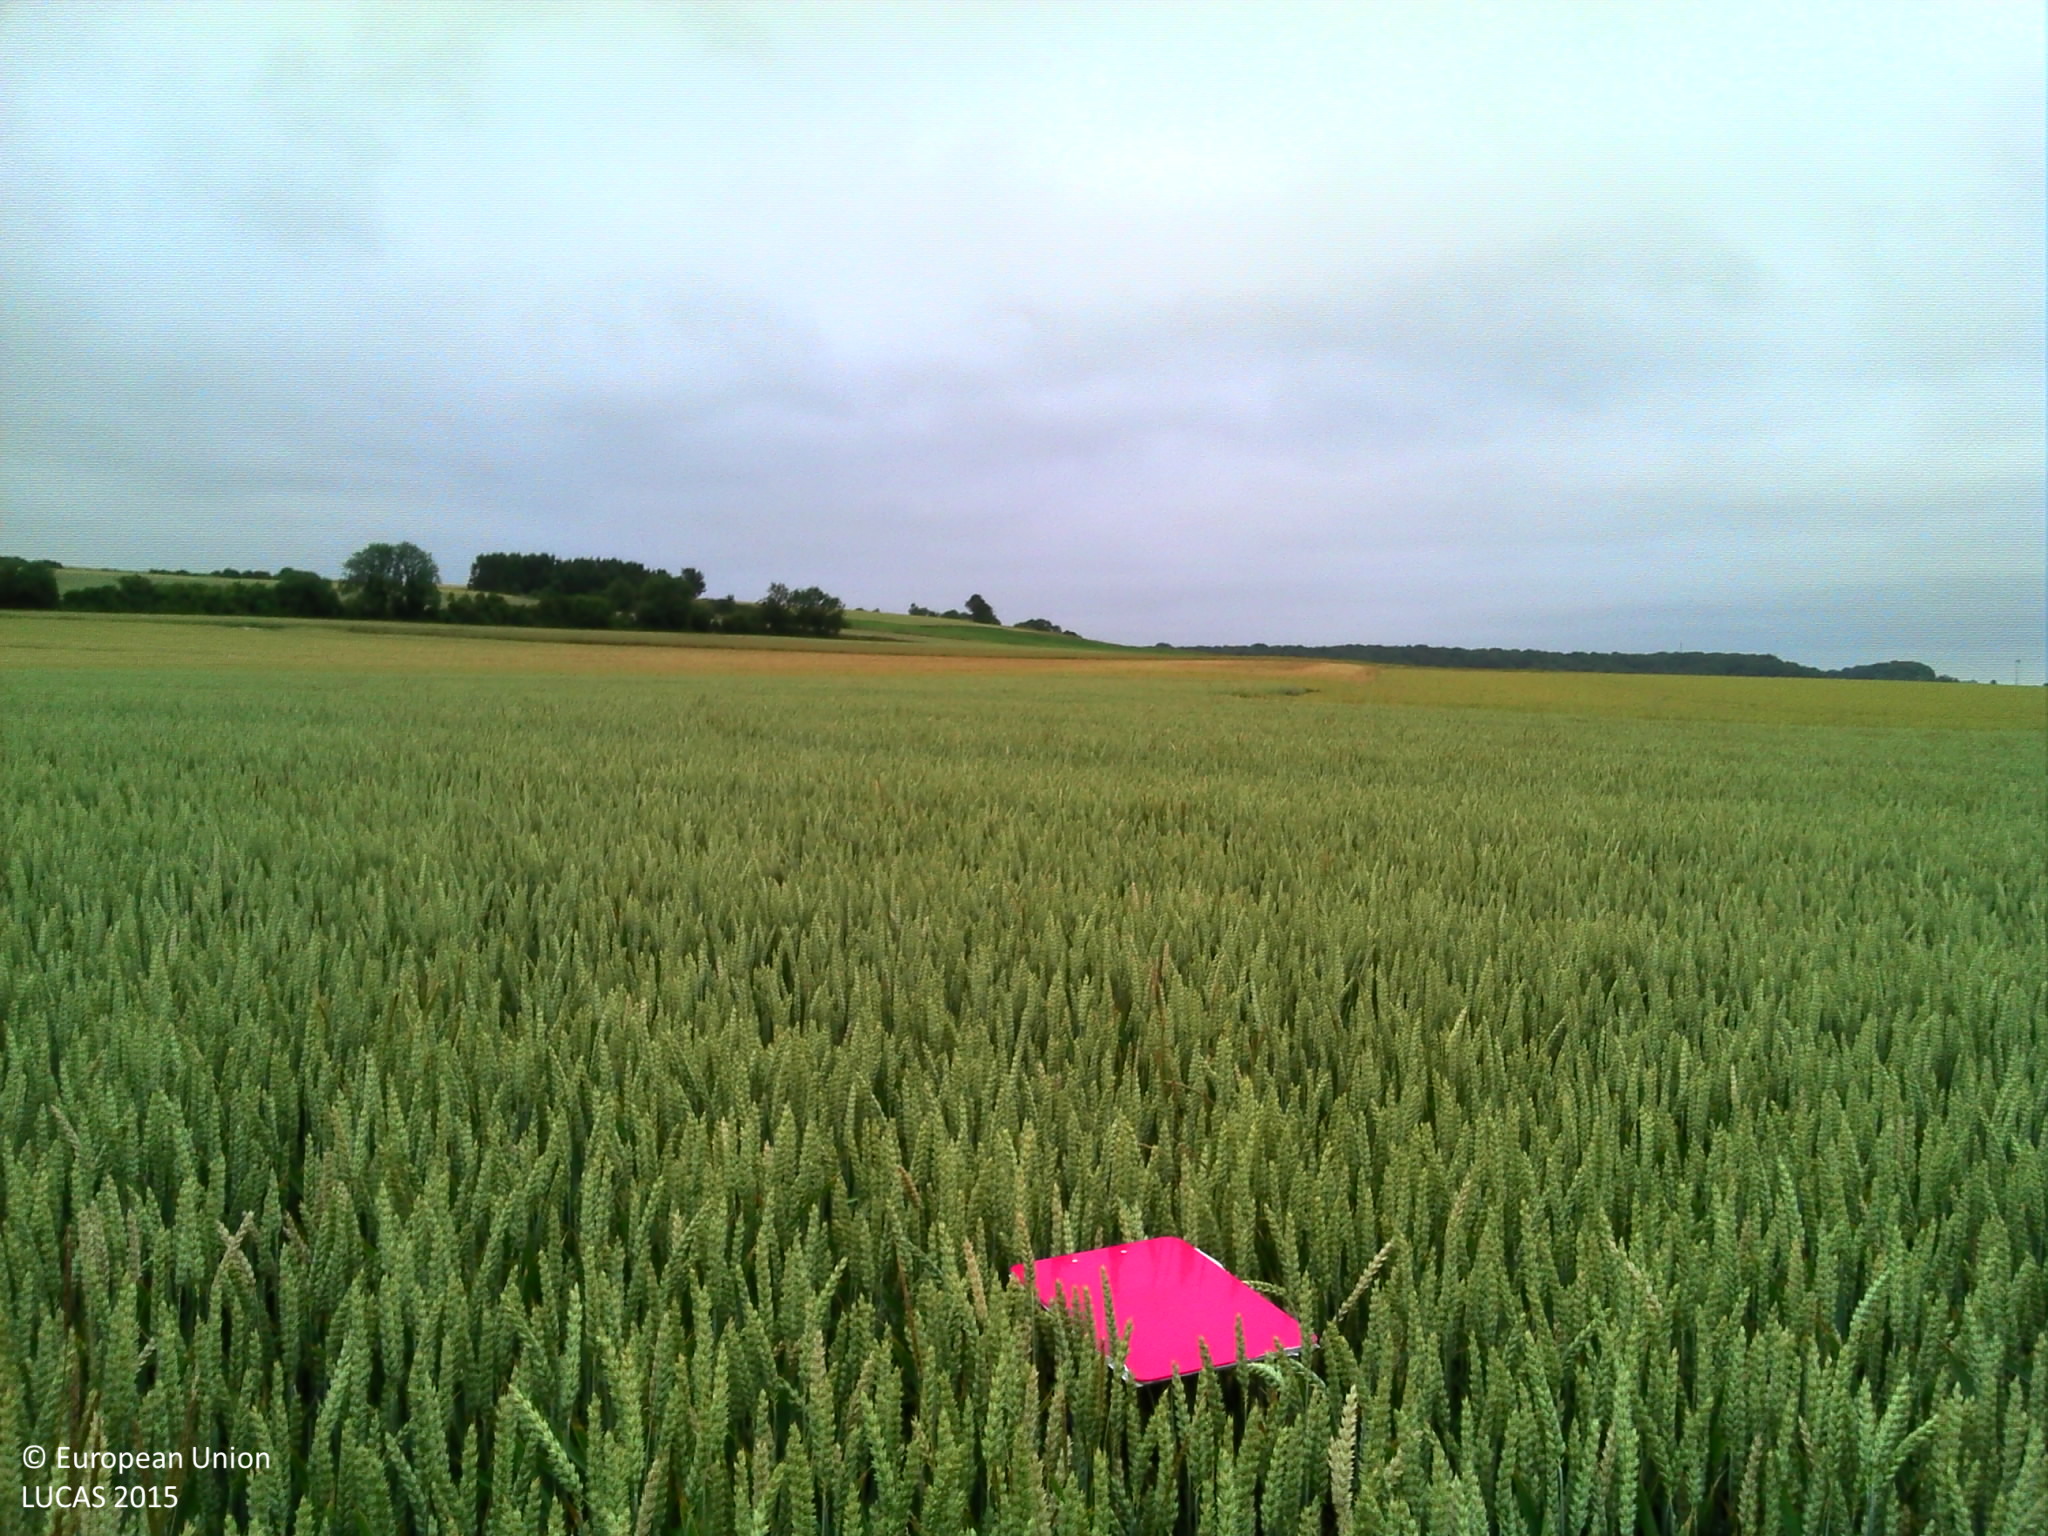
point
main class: Cropland
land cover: Common wheat
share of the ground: > 75 %
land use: Agriculture (excluding fallow land and kitchen gardens)
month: June
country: FR
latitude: 49.6169
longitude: 2.3050
